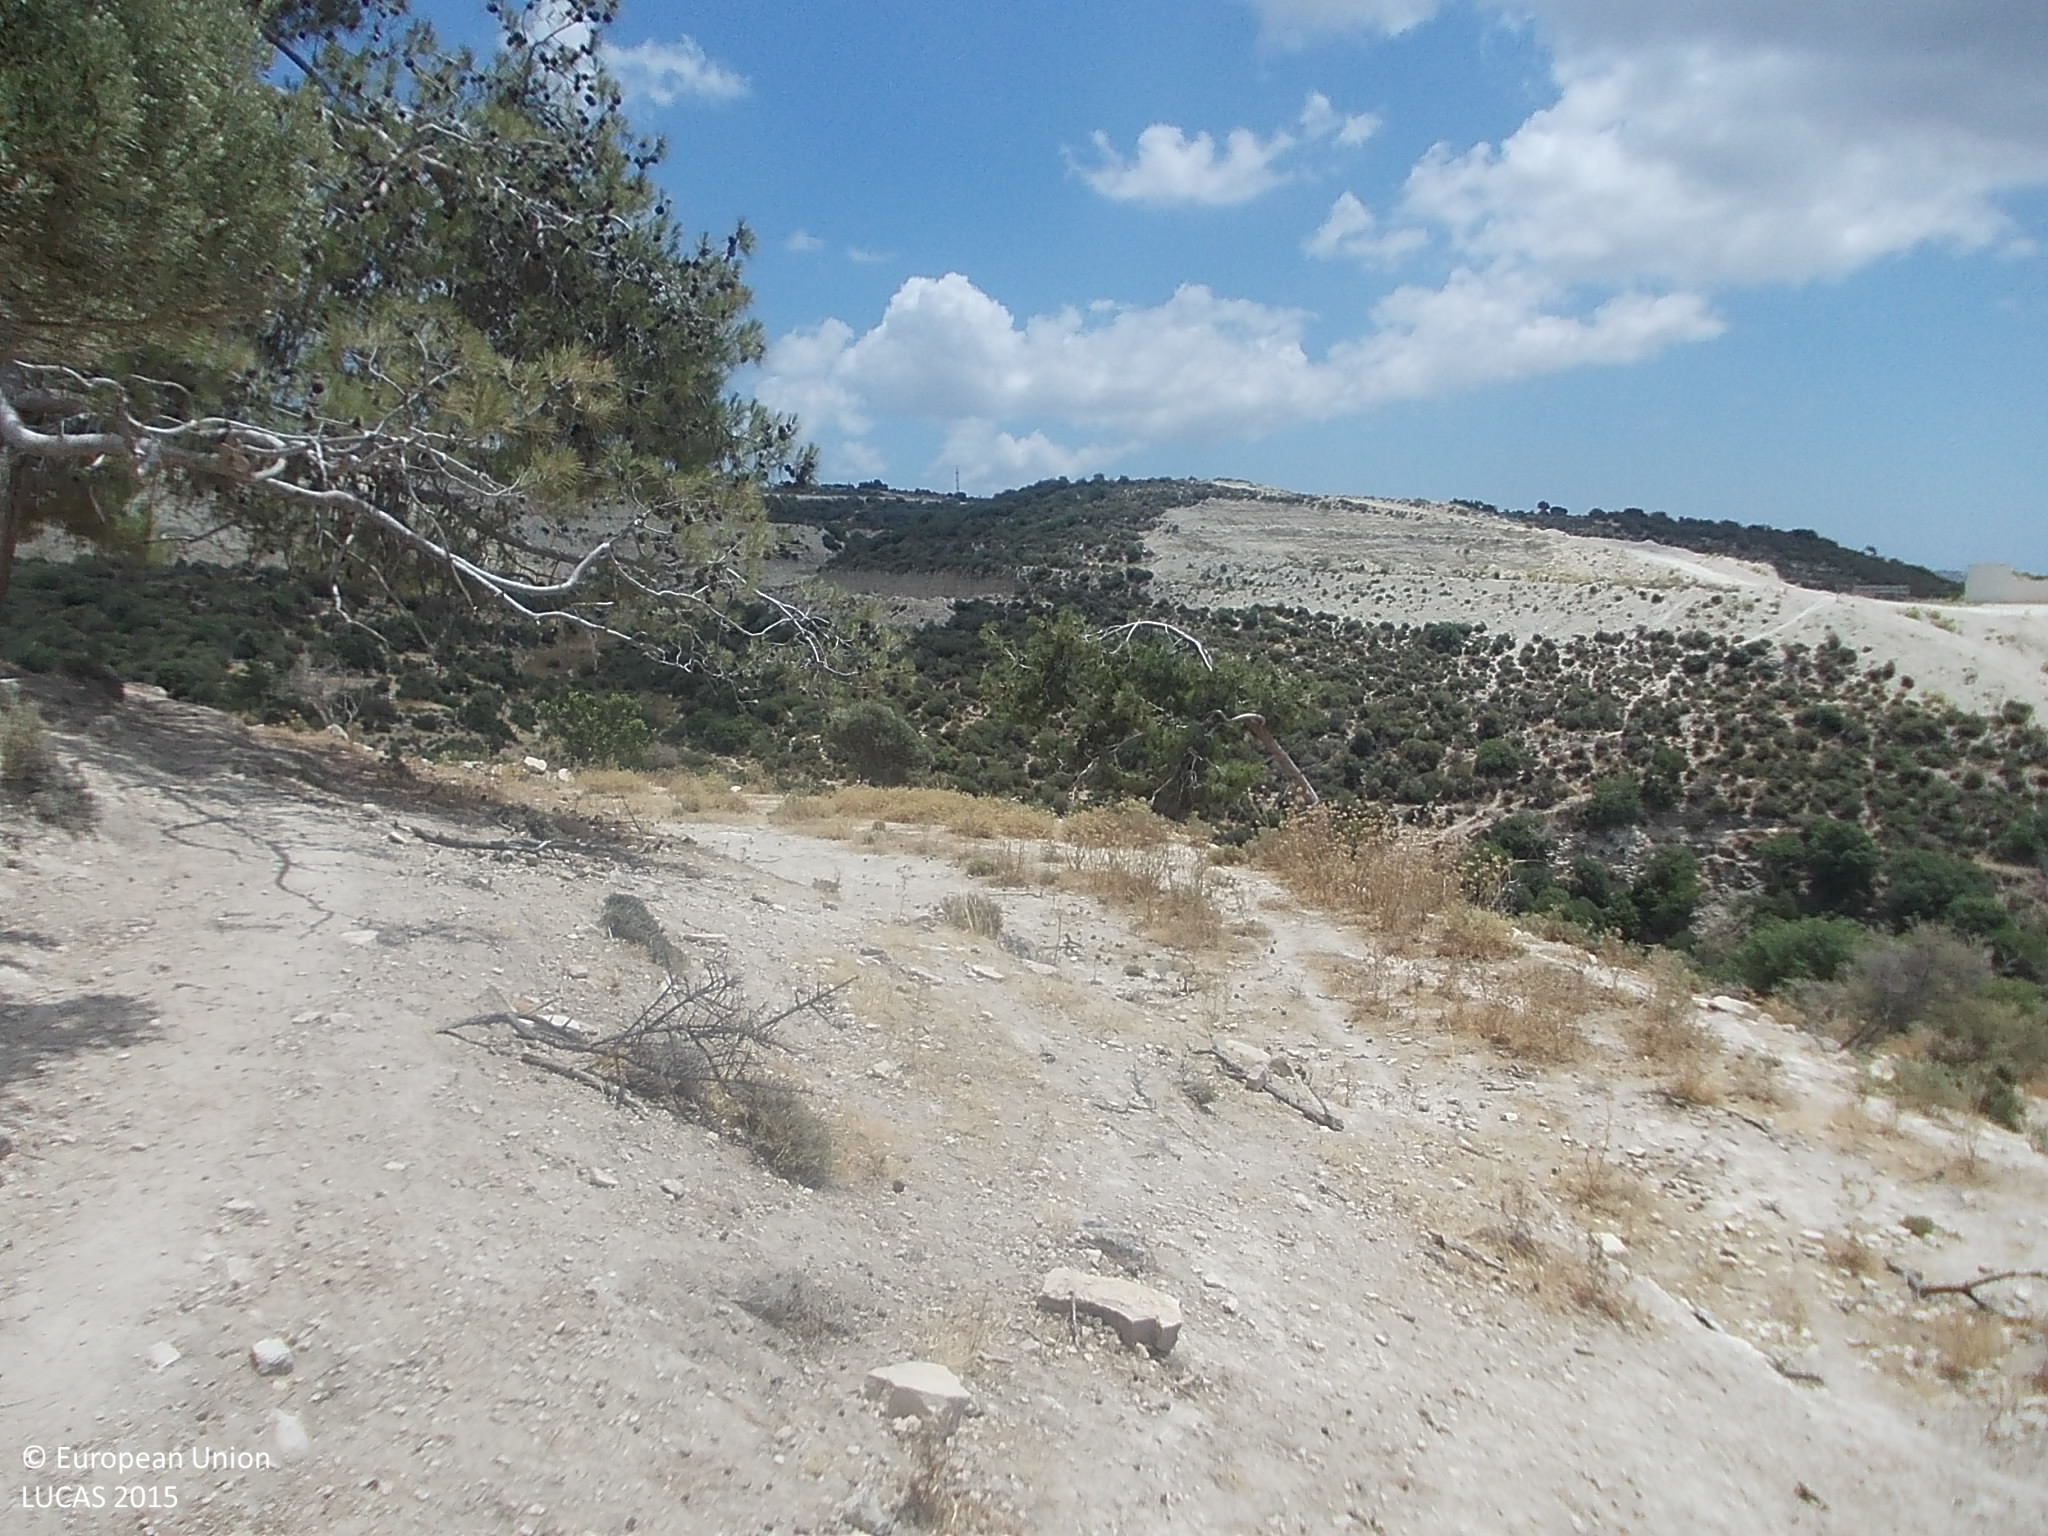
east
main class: Woodland
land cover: Pine dominated coniferous woodland
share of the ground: 25 - 50 %
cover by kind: coniferous forest trees 35 %, unconsolidated bare surface 30 %, consolidated bare surface 25 %, shrubs 5 %, herbaceous plants 5 %
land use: Semi-natural and natural areas not in use
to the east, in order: Pine dominated coniferous woodland; Tracks; Shrubland with sparse tree cover; Dry stone walls; Broadleaved woodland; Rivers and streams; Broadleaved woodland; Shrubland with sparse tree cover; Shrubland without tree cover
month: June
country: CY
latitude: 34.7758
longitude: 32.9244
